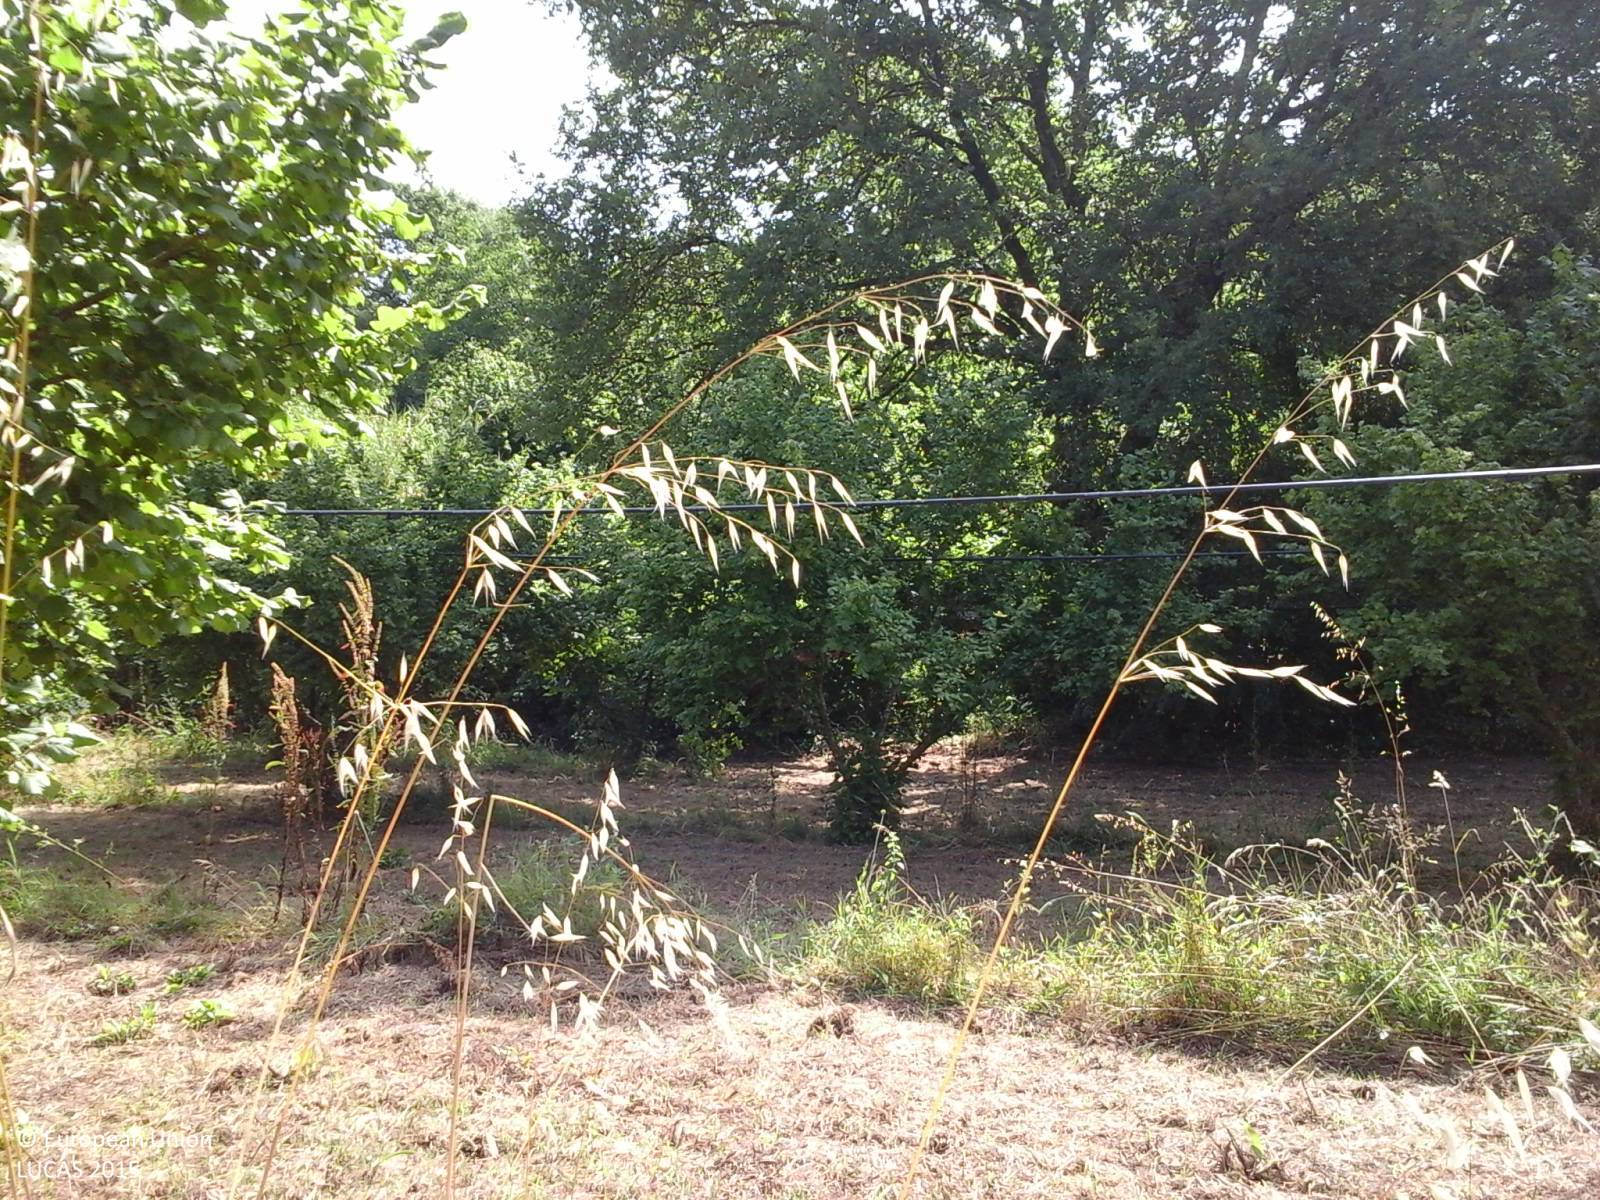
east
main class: Cropland
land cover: Nuts trees
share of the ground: > 75 %
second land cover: Grassland without tree/shrub cover
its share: > 75 %
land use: Agriculture (excluding fallow land and kitchen gardens)
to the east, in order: Nuts trees; Grassland without tree/shrub cover; Single bushes/trees; Nuts trees; Single bushes/trees; Fences; Broadleaved woodland; Tracks; Olive groves; Other fruit trees and berries; Olive groves; Fences; Broadleaved woodland; Fences; Grass margins; Paved roads, cycling and walking lanes; Lines of trees; Grassland without tree/shrub cover; Artificial constructions in urban areas
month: June
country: IT
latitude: 42.4305
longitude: 12.2411
